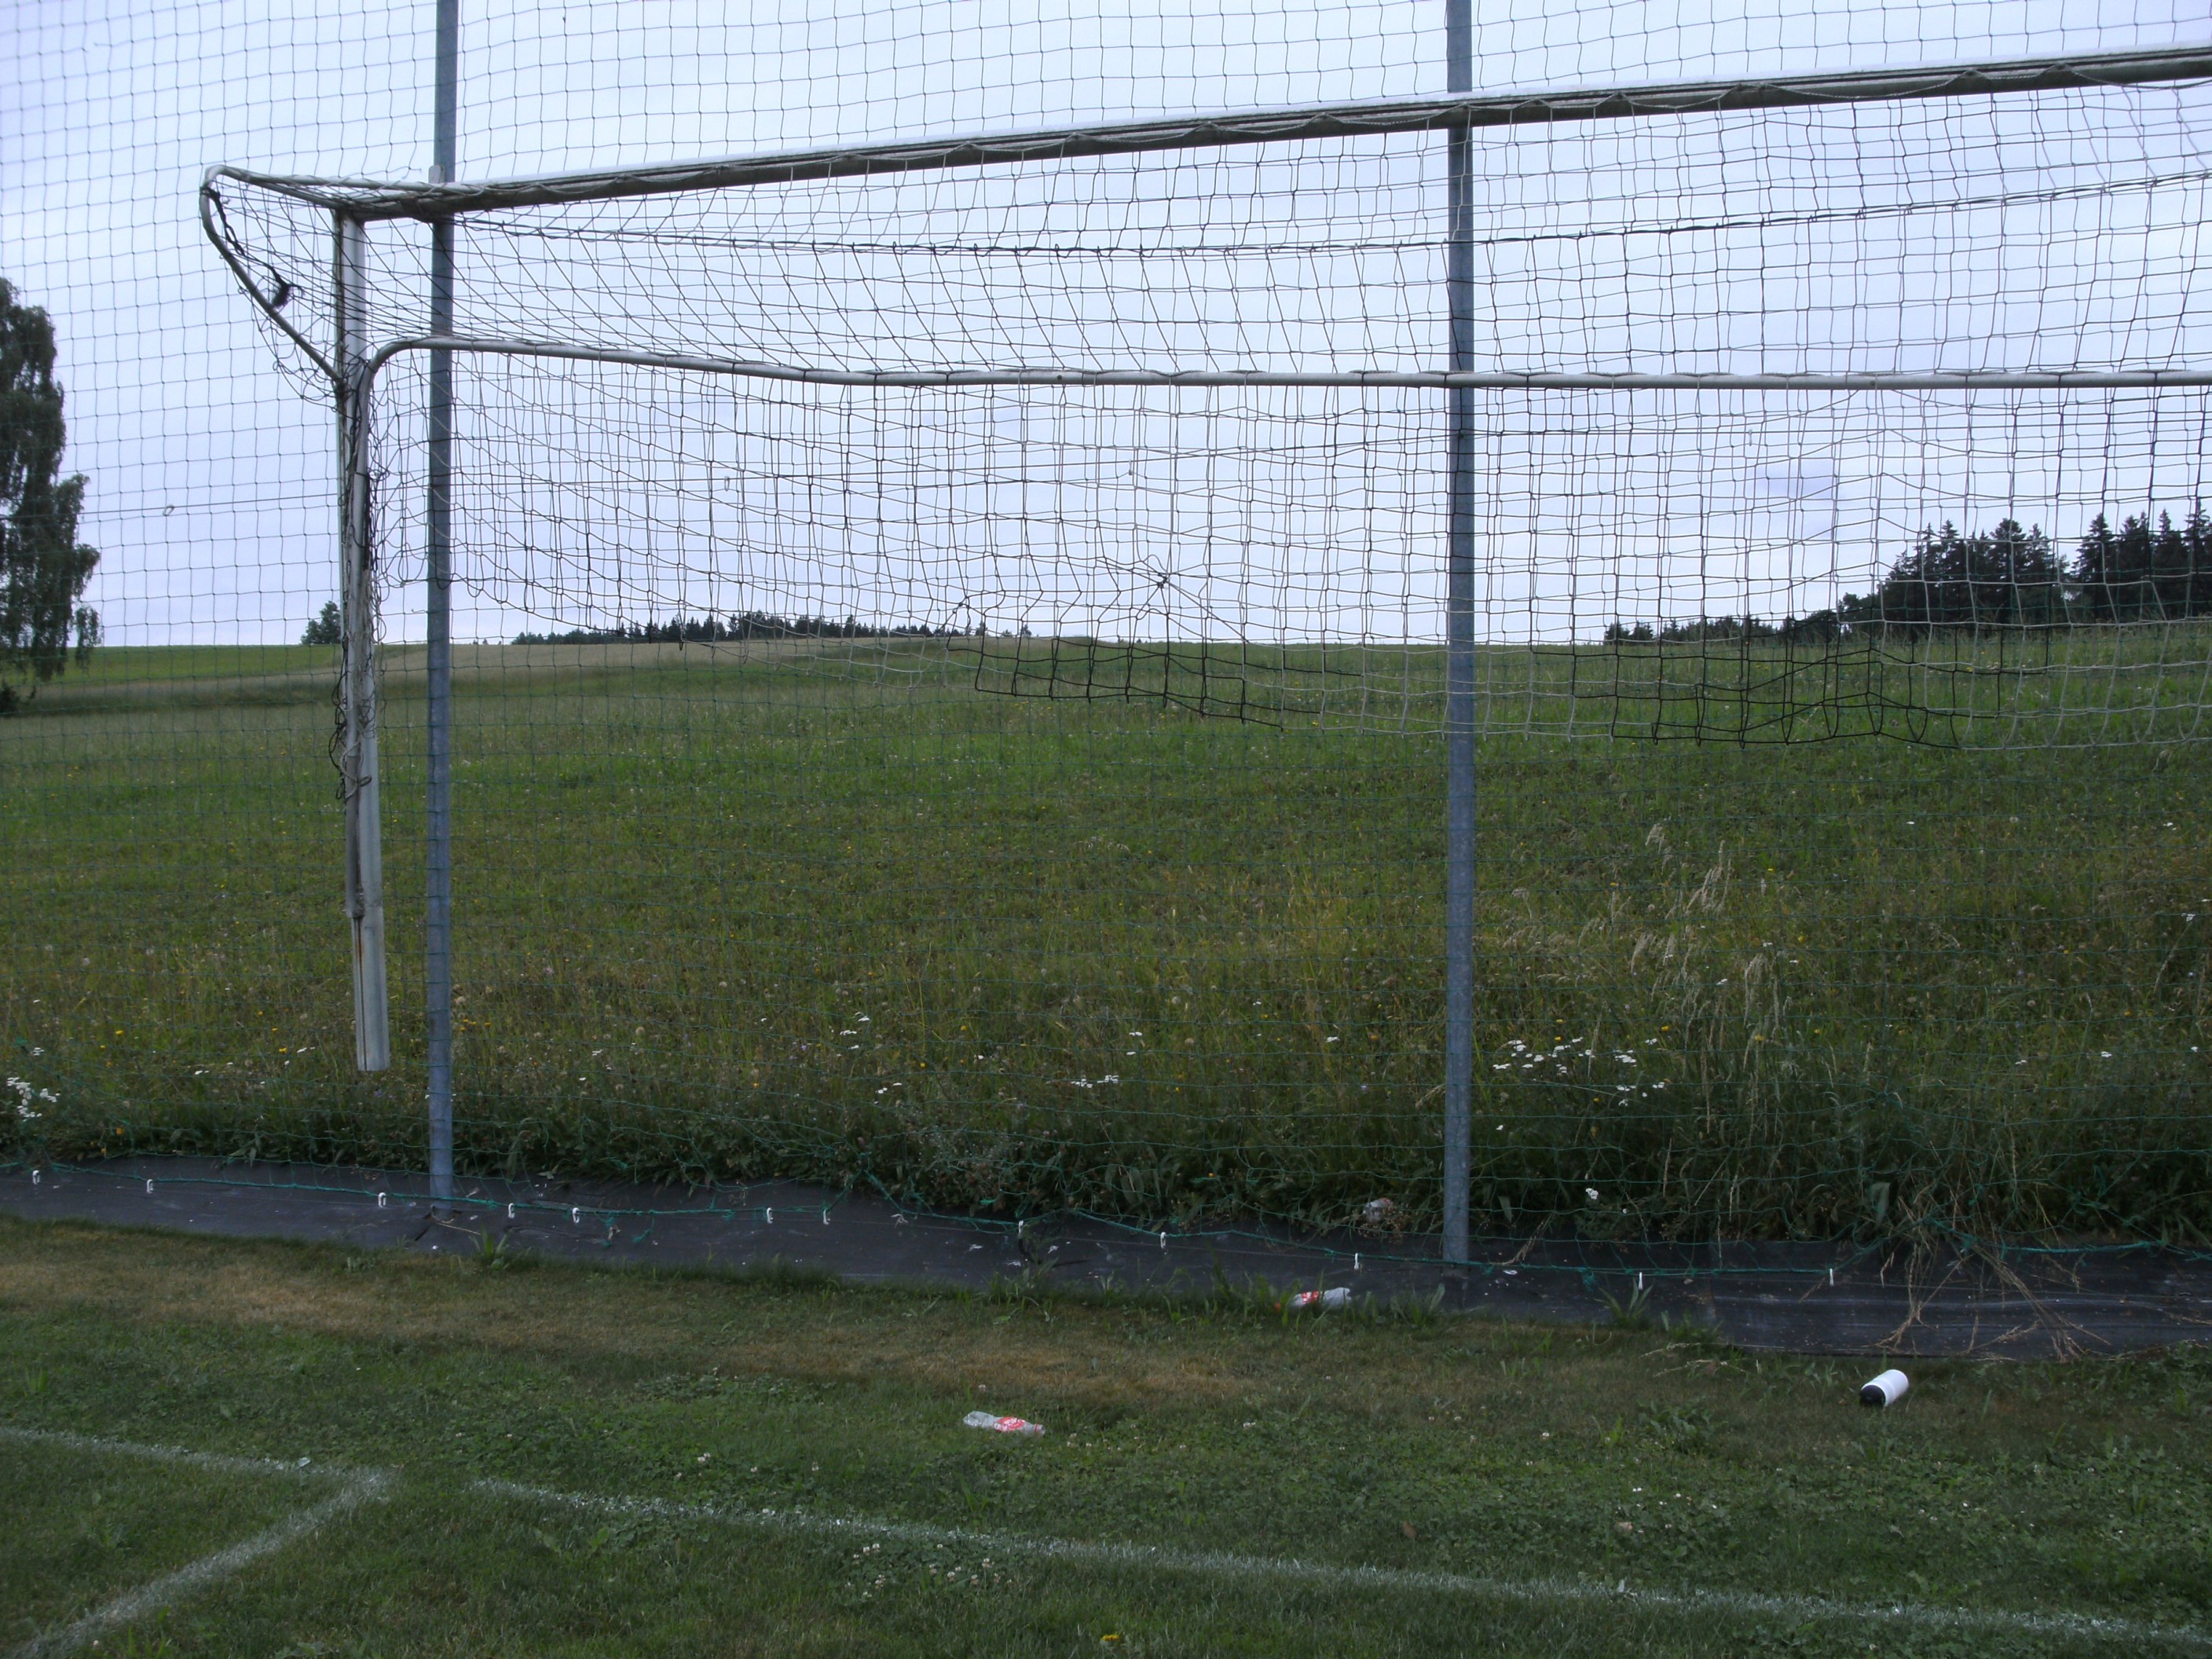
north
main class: Grassland
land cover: Grassland without tree/shrub cover
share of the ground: > 75 %
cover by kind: herbaceous plants 100 %
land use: Sport
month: June
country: AT
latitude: 48.4348
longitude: 14.1226
